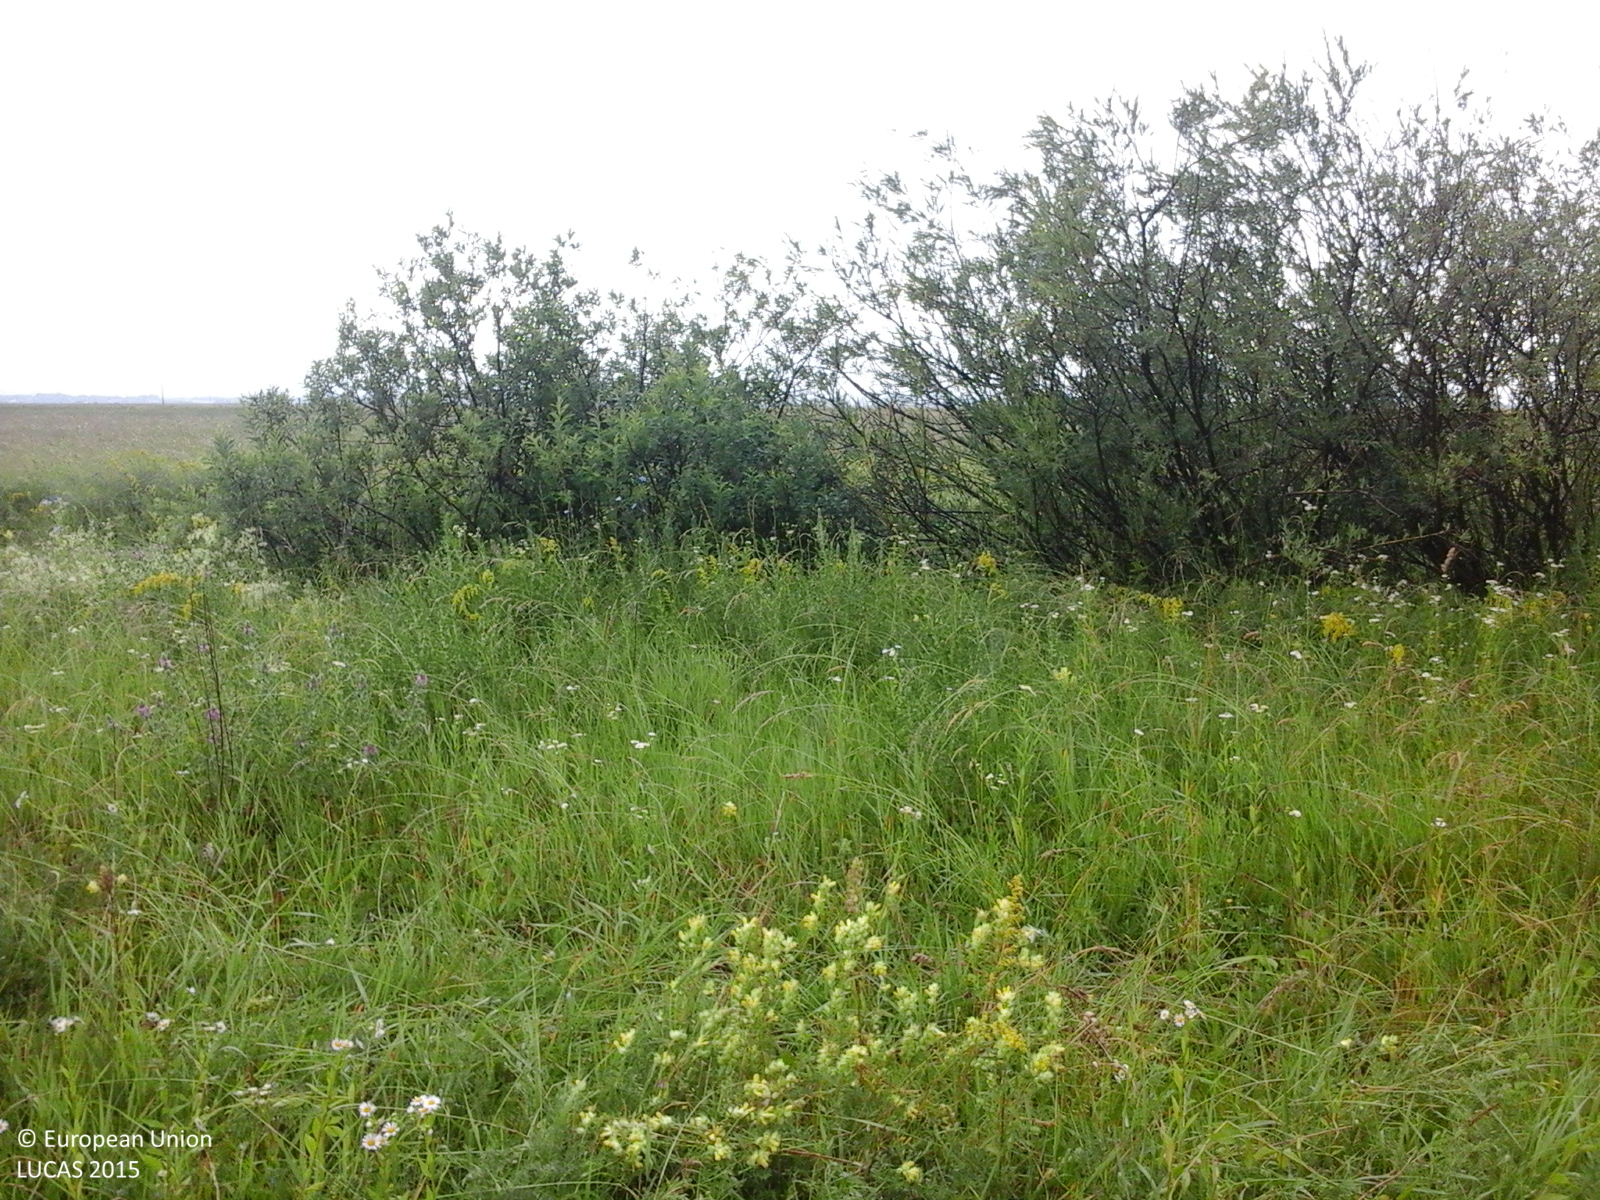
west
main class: Grassland
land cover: Spontaneously vegetated surfaces
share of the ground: > 75 %
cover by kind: herbaceous plants 100 %
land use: Fallow land
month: June
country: RO
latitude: 47.8818
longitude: 25.9218
